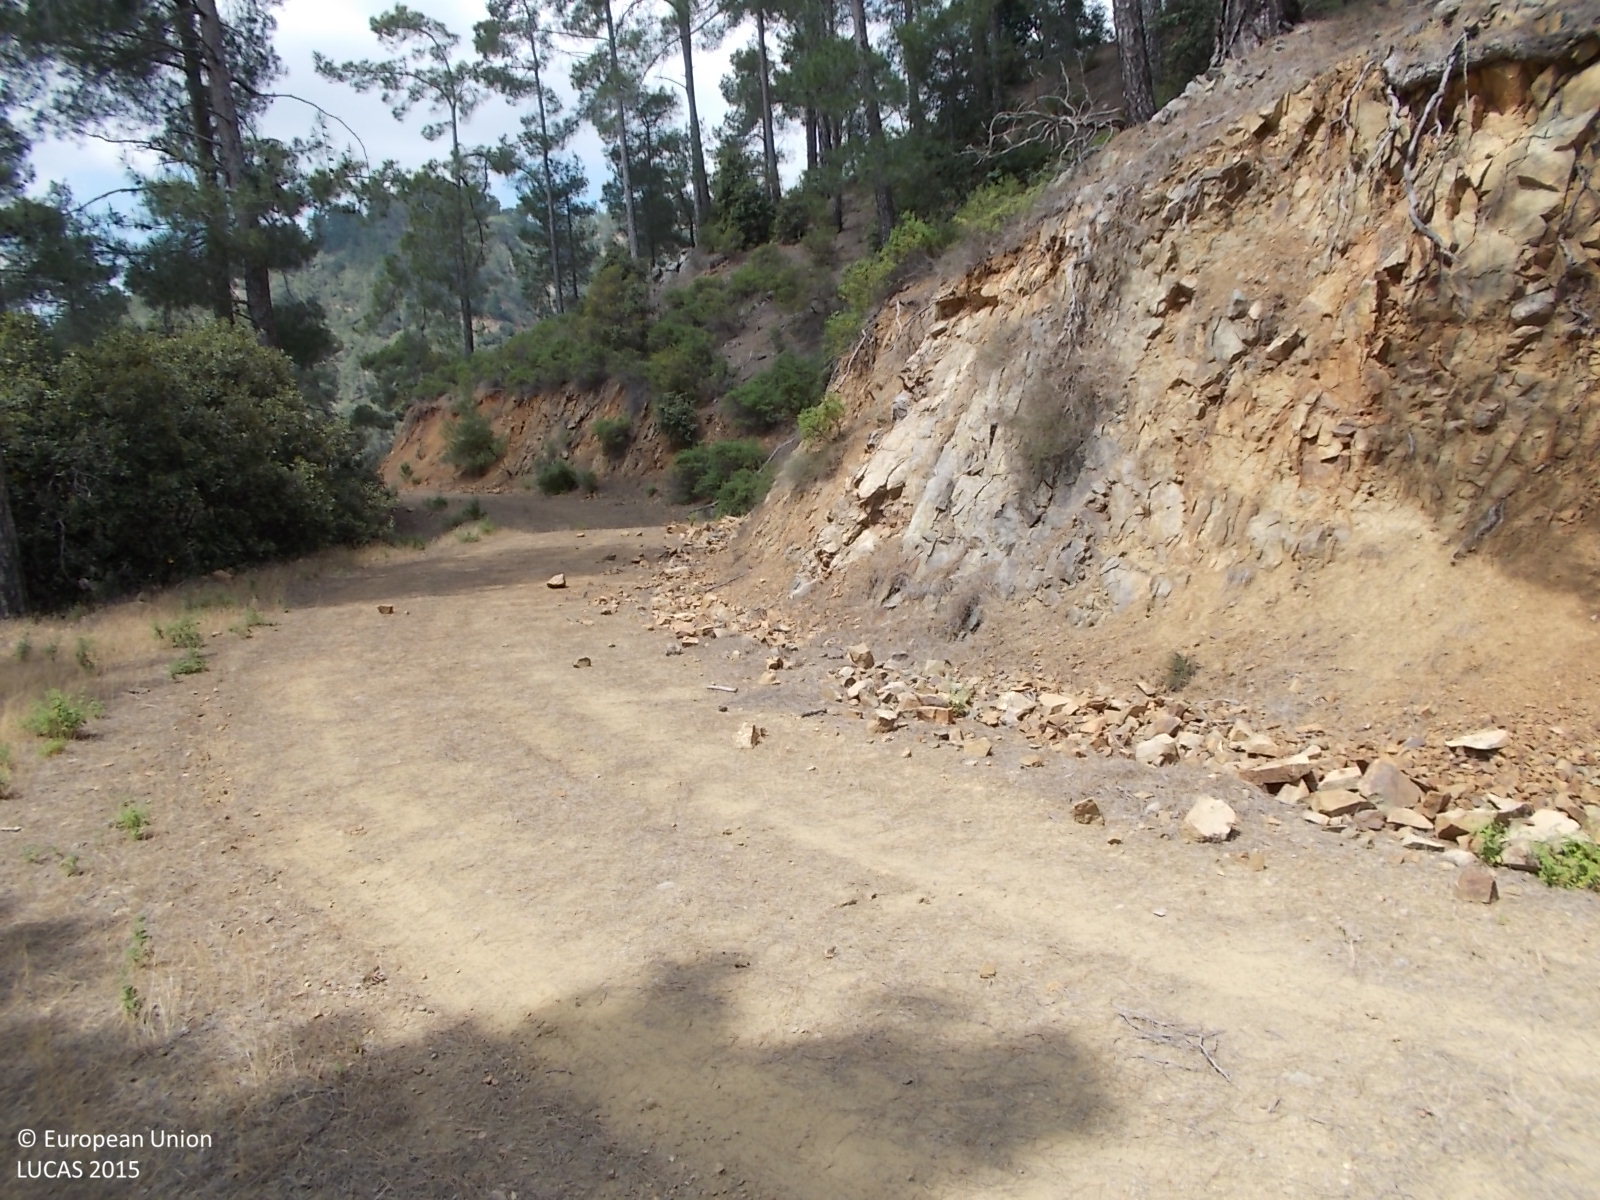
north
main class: Woodland
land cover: Pine dominated mixed woodland
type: coniferous forest of the mediterranean region
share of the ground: > 75 %
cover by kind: coniferous forest trees 70 %, broadleaved forest trees 25 %, shrubs 5 %
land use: Semi-natural and natural areas not in use
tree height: > 5 m
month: June
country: CY
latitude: 35.0102
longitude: 32.5898
